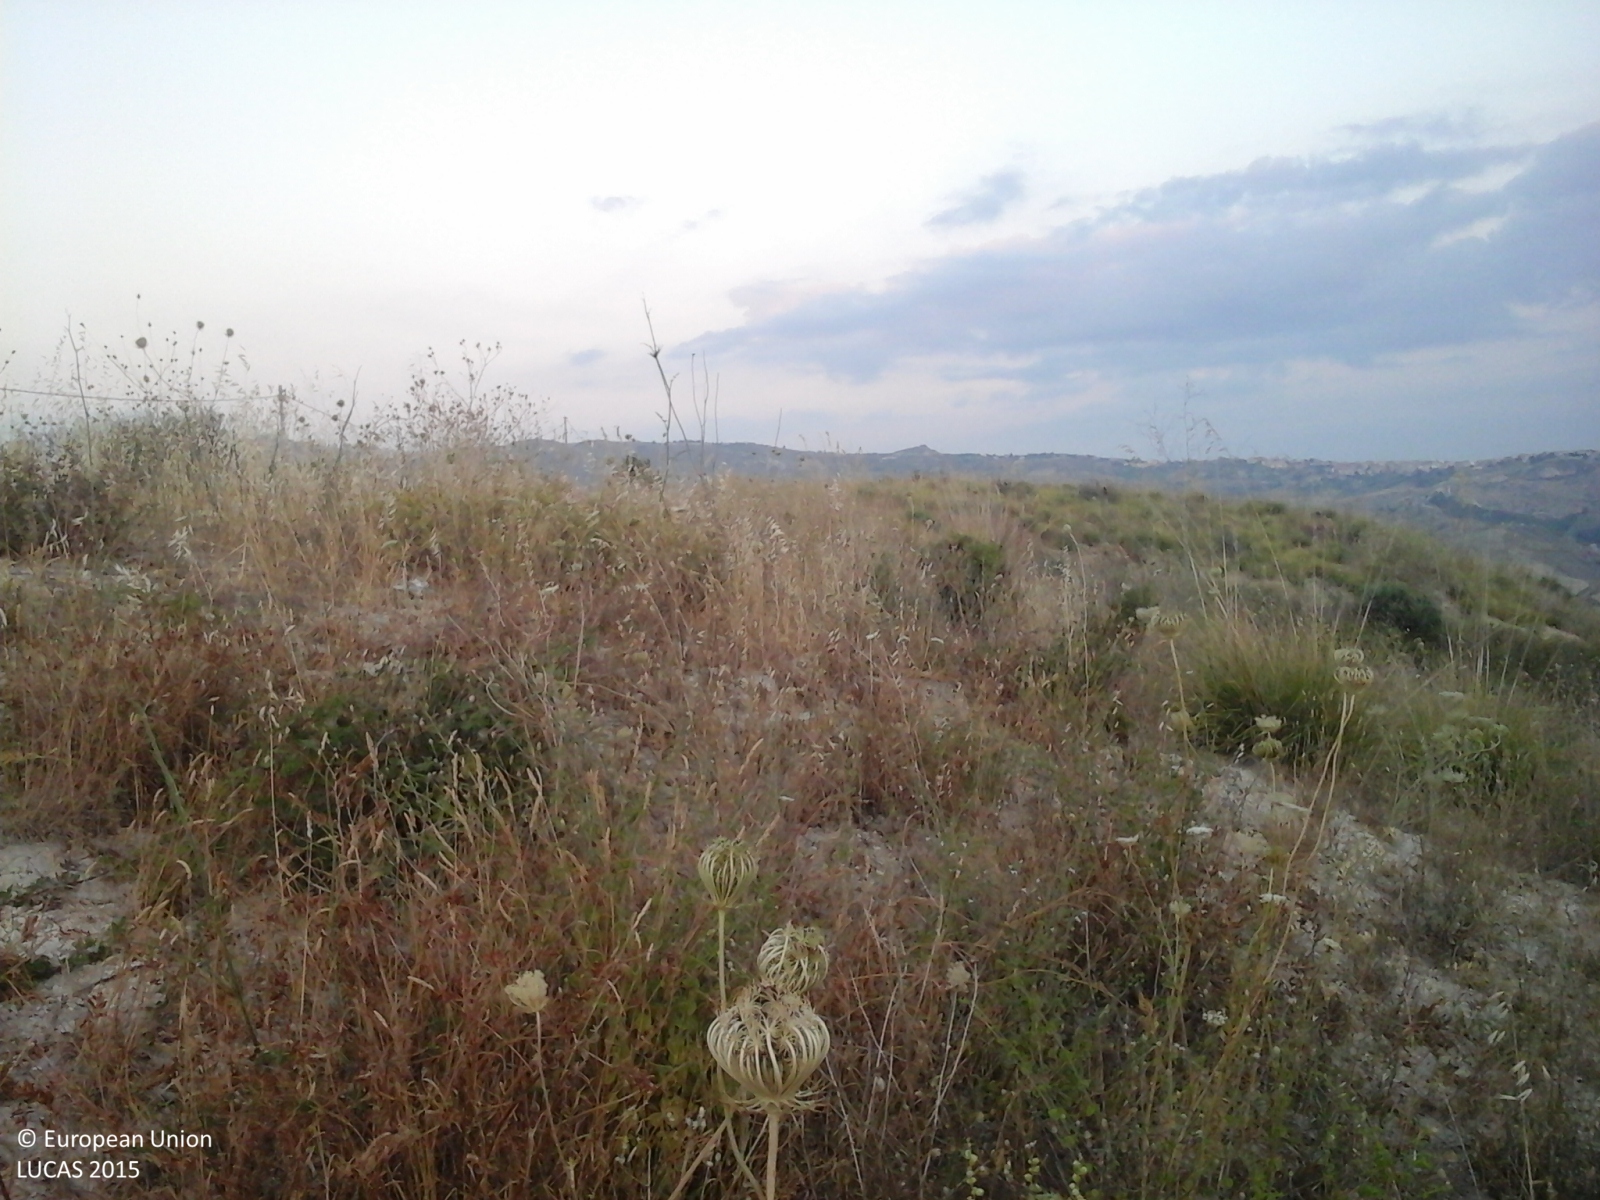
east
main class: Cropland
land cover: Durum wheat
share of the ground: > 75 %
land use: Agriculture (excluding fallow land and kitchen gardens)
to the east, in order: Durum wheat; Grassland without tree/shrub cover; Durum wheat; Ditches and canals
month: July
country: IT
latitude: 37.5380
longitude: 13.4932
